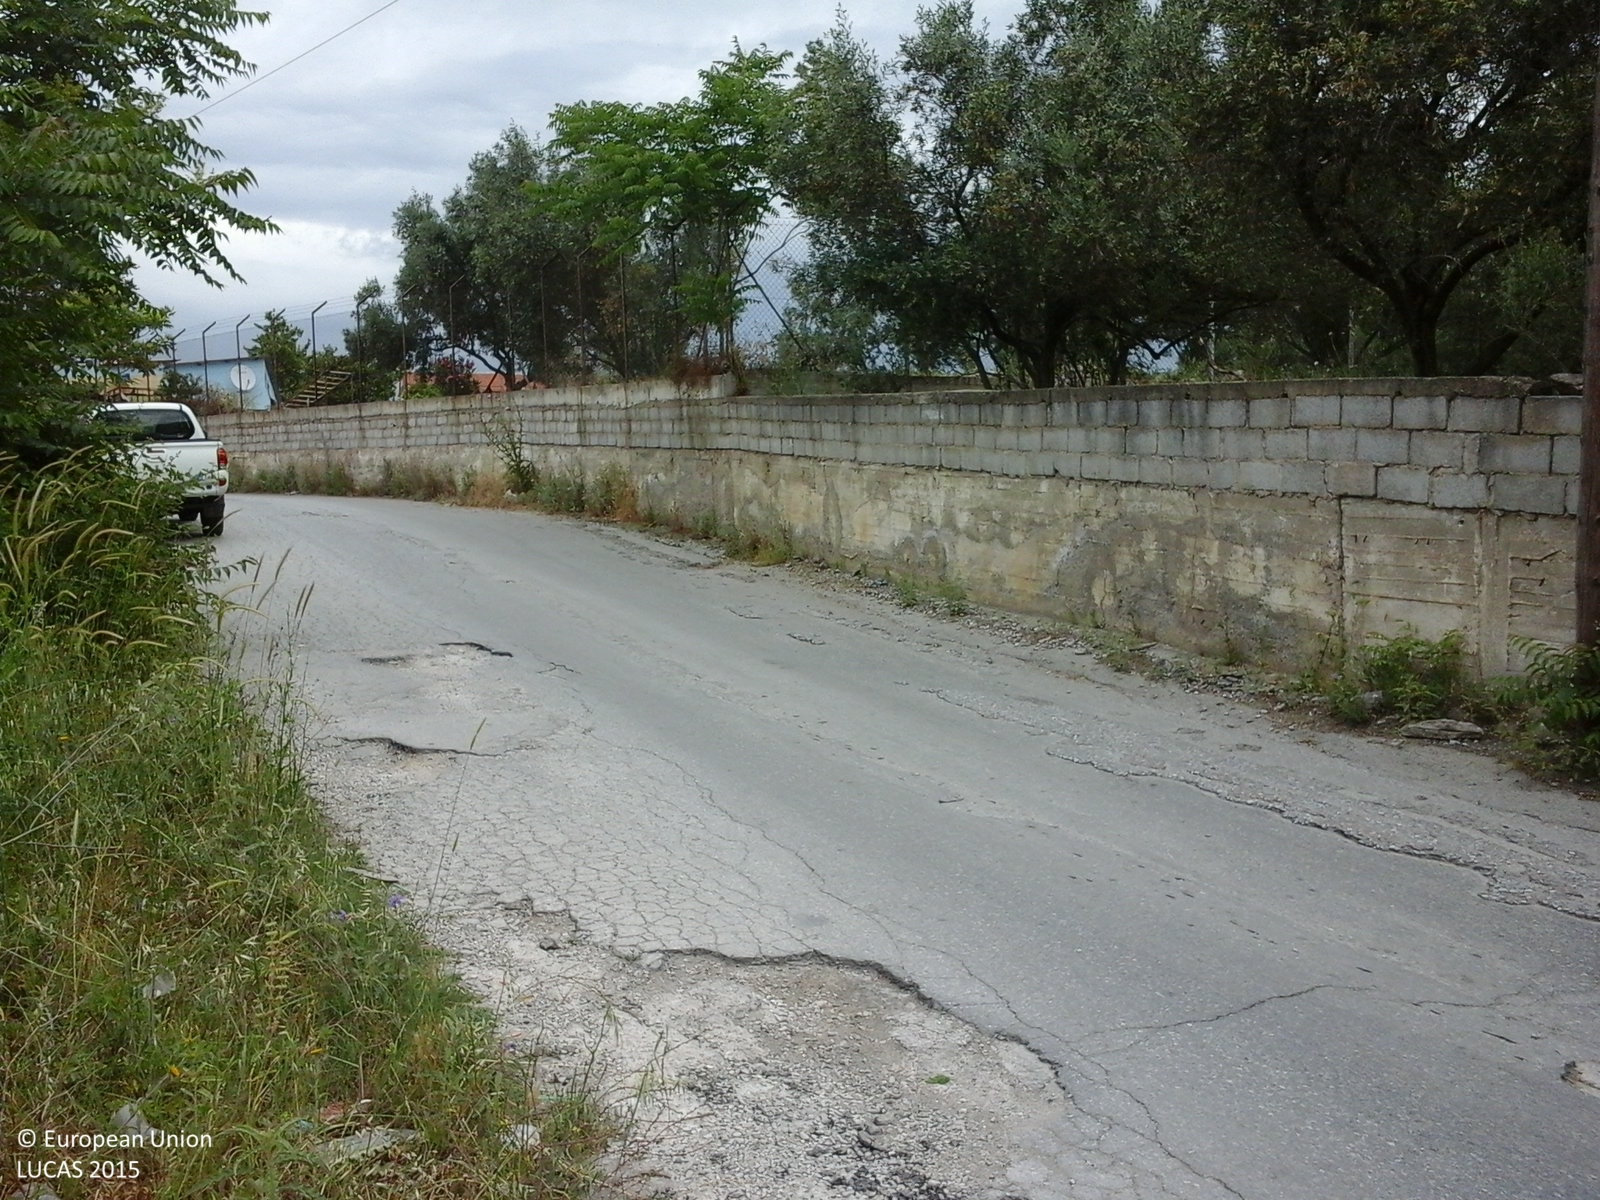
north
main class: Woodland
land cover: Broadleaved woodland
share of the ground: > 75 %
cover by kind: broadleaved forest trees 100 %
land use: Semi-natural and natural areas not in use
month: May
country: GR
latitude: 40.7047
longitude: 22.9445
